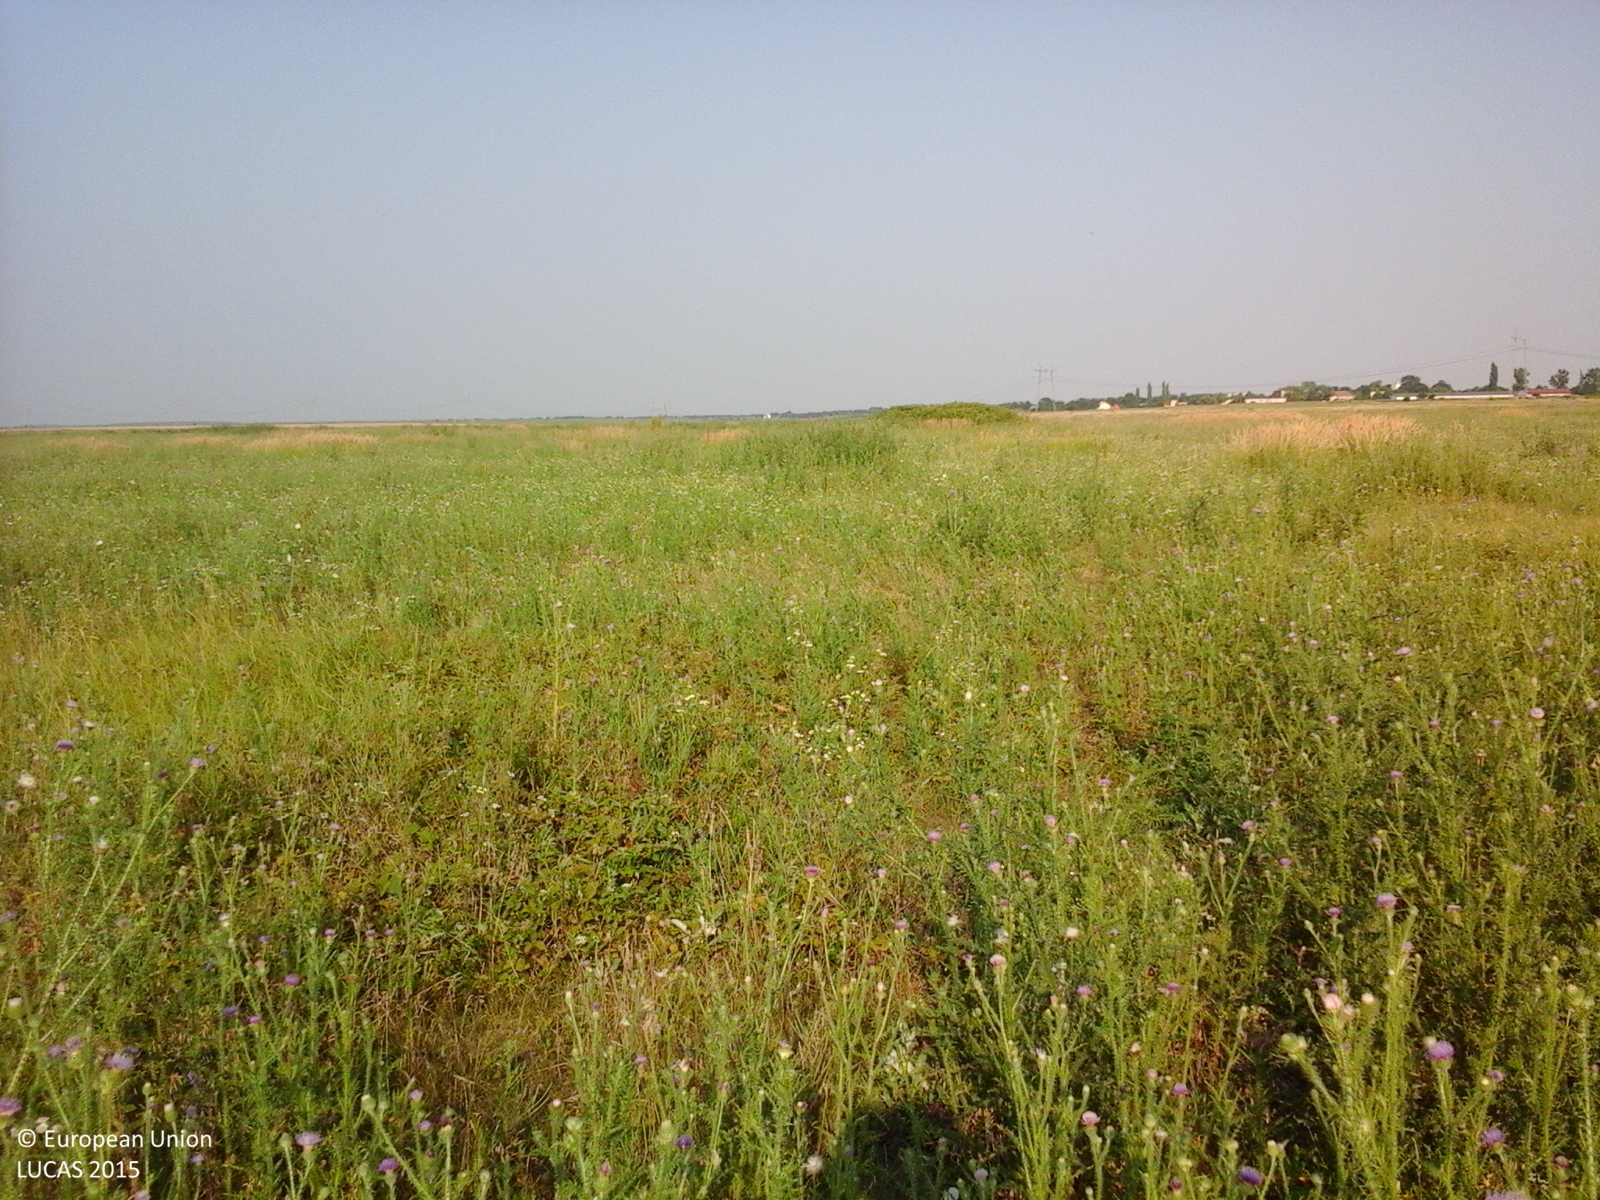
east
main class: Grassland
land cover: Spontaneously vegetated surfaces
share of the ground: > 75 %
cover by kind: herbaceous plants 100 %
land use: Fallow land
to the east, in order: Spontaneously vegetated surfaces; Tracks; Spontaneously vegetated surfaces; Tracks; Spontaneously vegetated surfaces; Tracks; Spontaneously vegetated surfaces
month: July
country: RO
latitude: 44.4753
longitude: 26.4704
